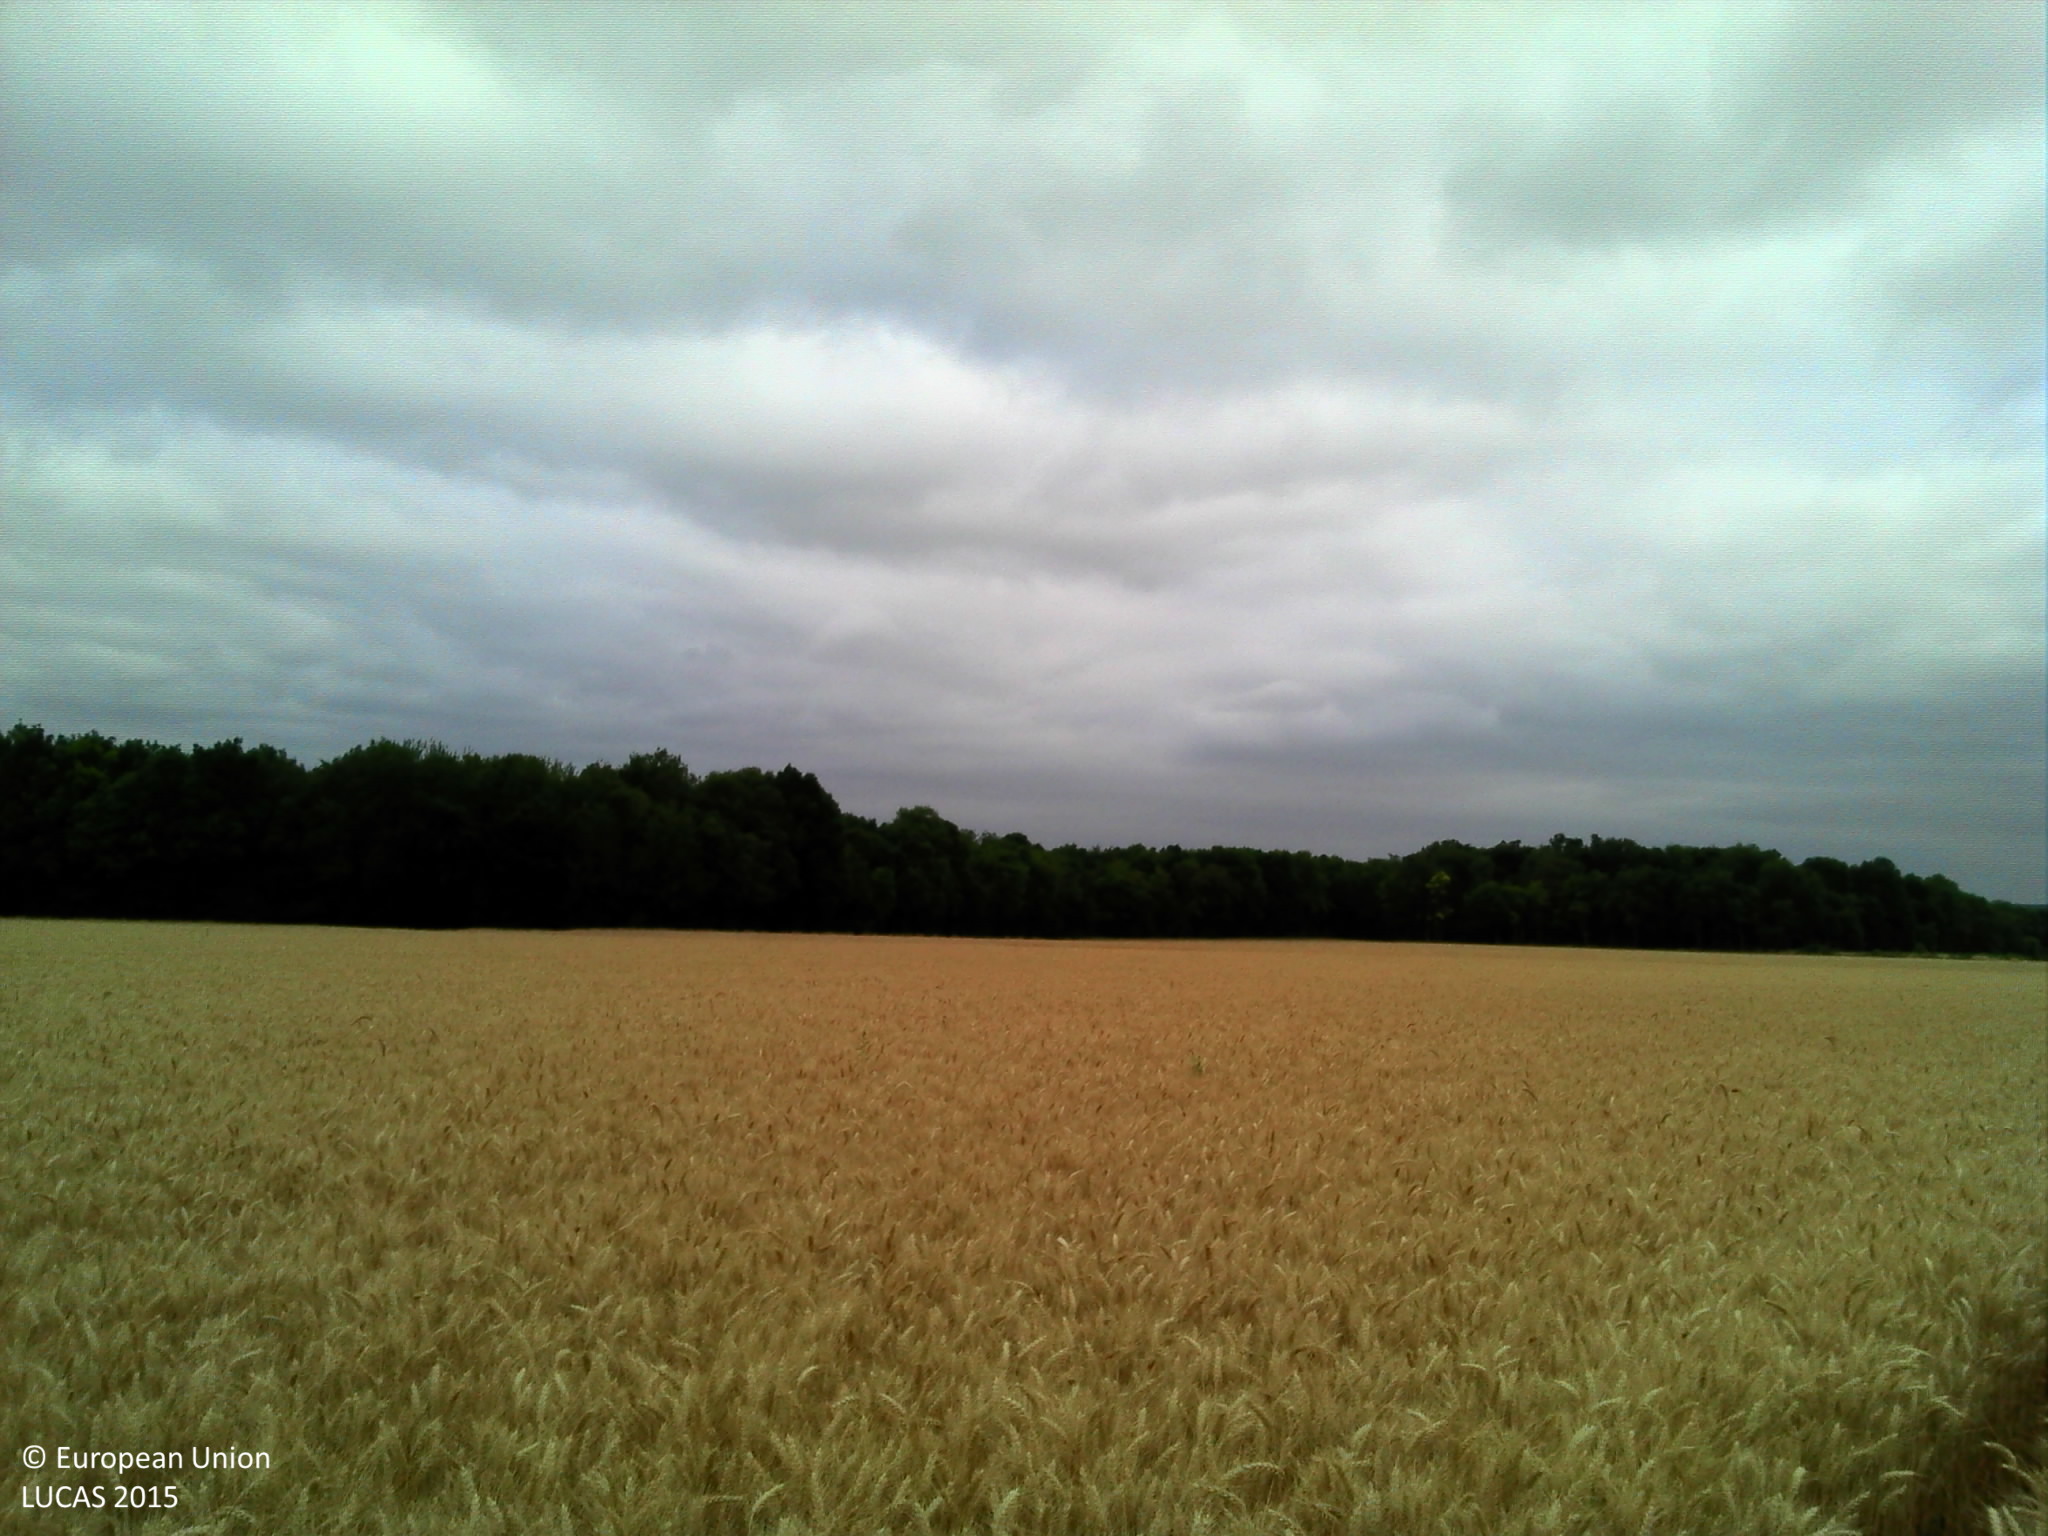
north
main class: Cropland
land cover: Common wheat
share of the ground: > 75 %
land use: Agriculture (excluding fallow land and kitchen gardens)
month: July
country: FR
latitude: 49.3252
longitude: 2.2681
